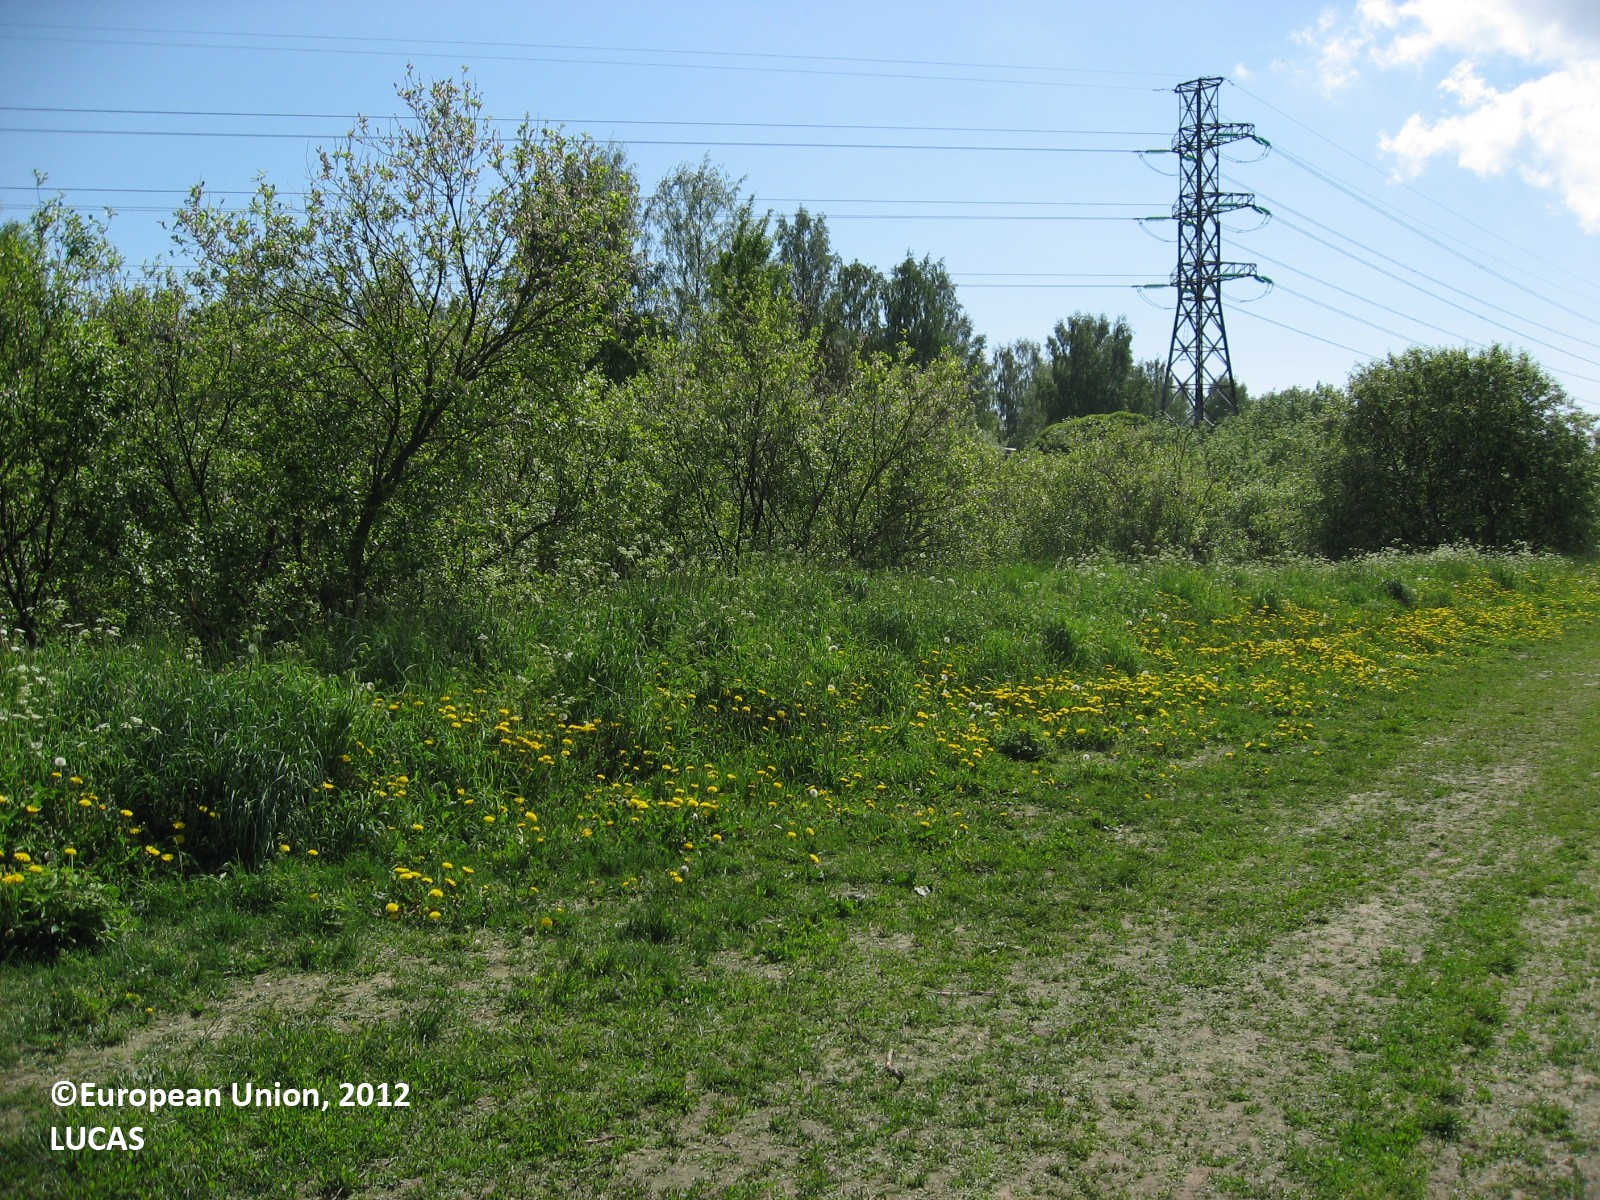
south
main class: Cropland
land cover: Common wheat
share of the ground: 50 - 75 %
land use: Agriculture (excluding fallow land and kitchen gardens)
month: June
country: FI
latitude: 60.2487
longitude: 24.8763
